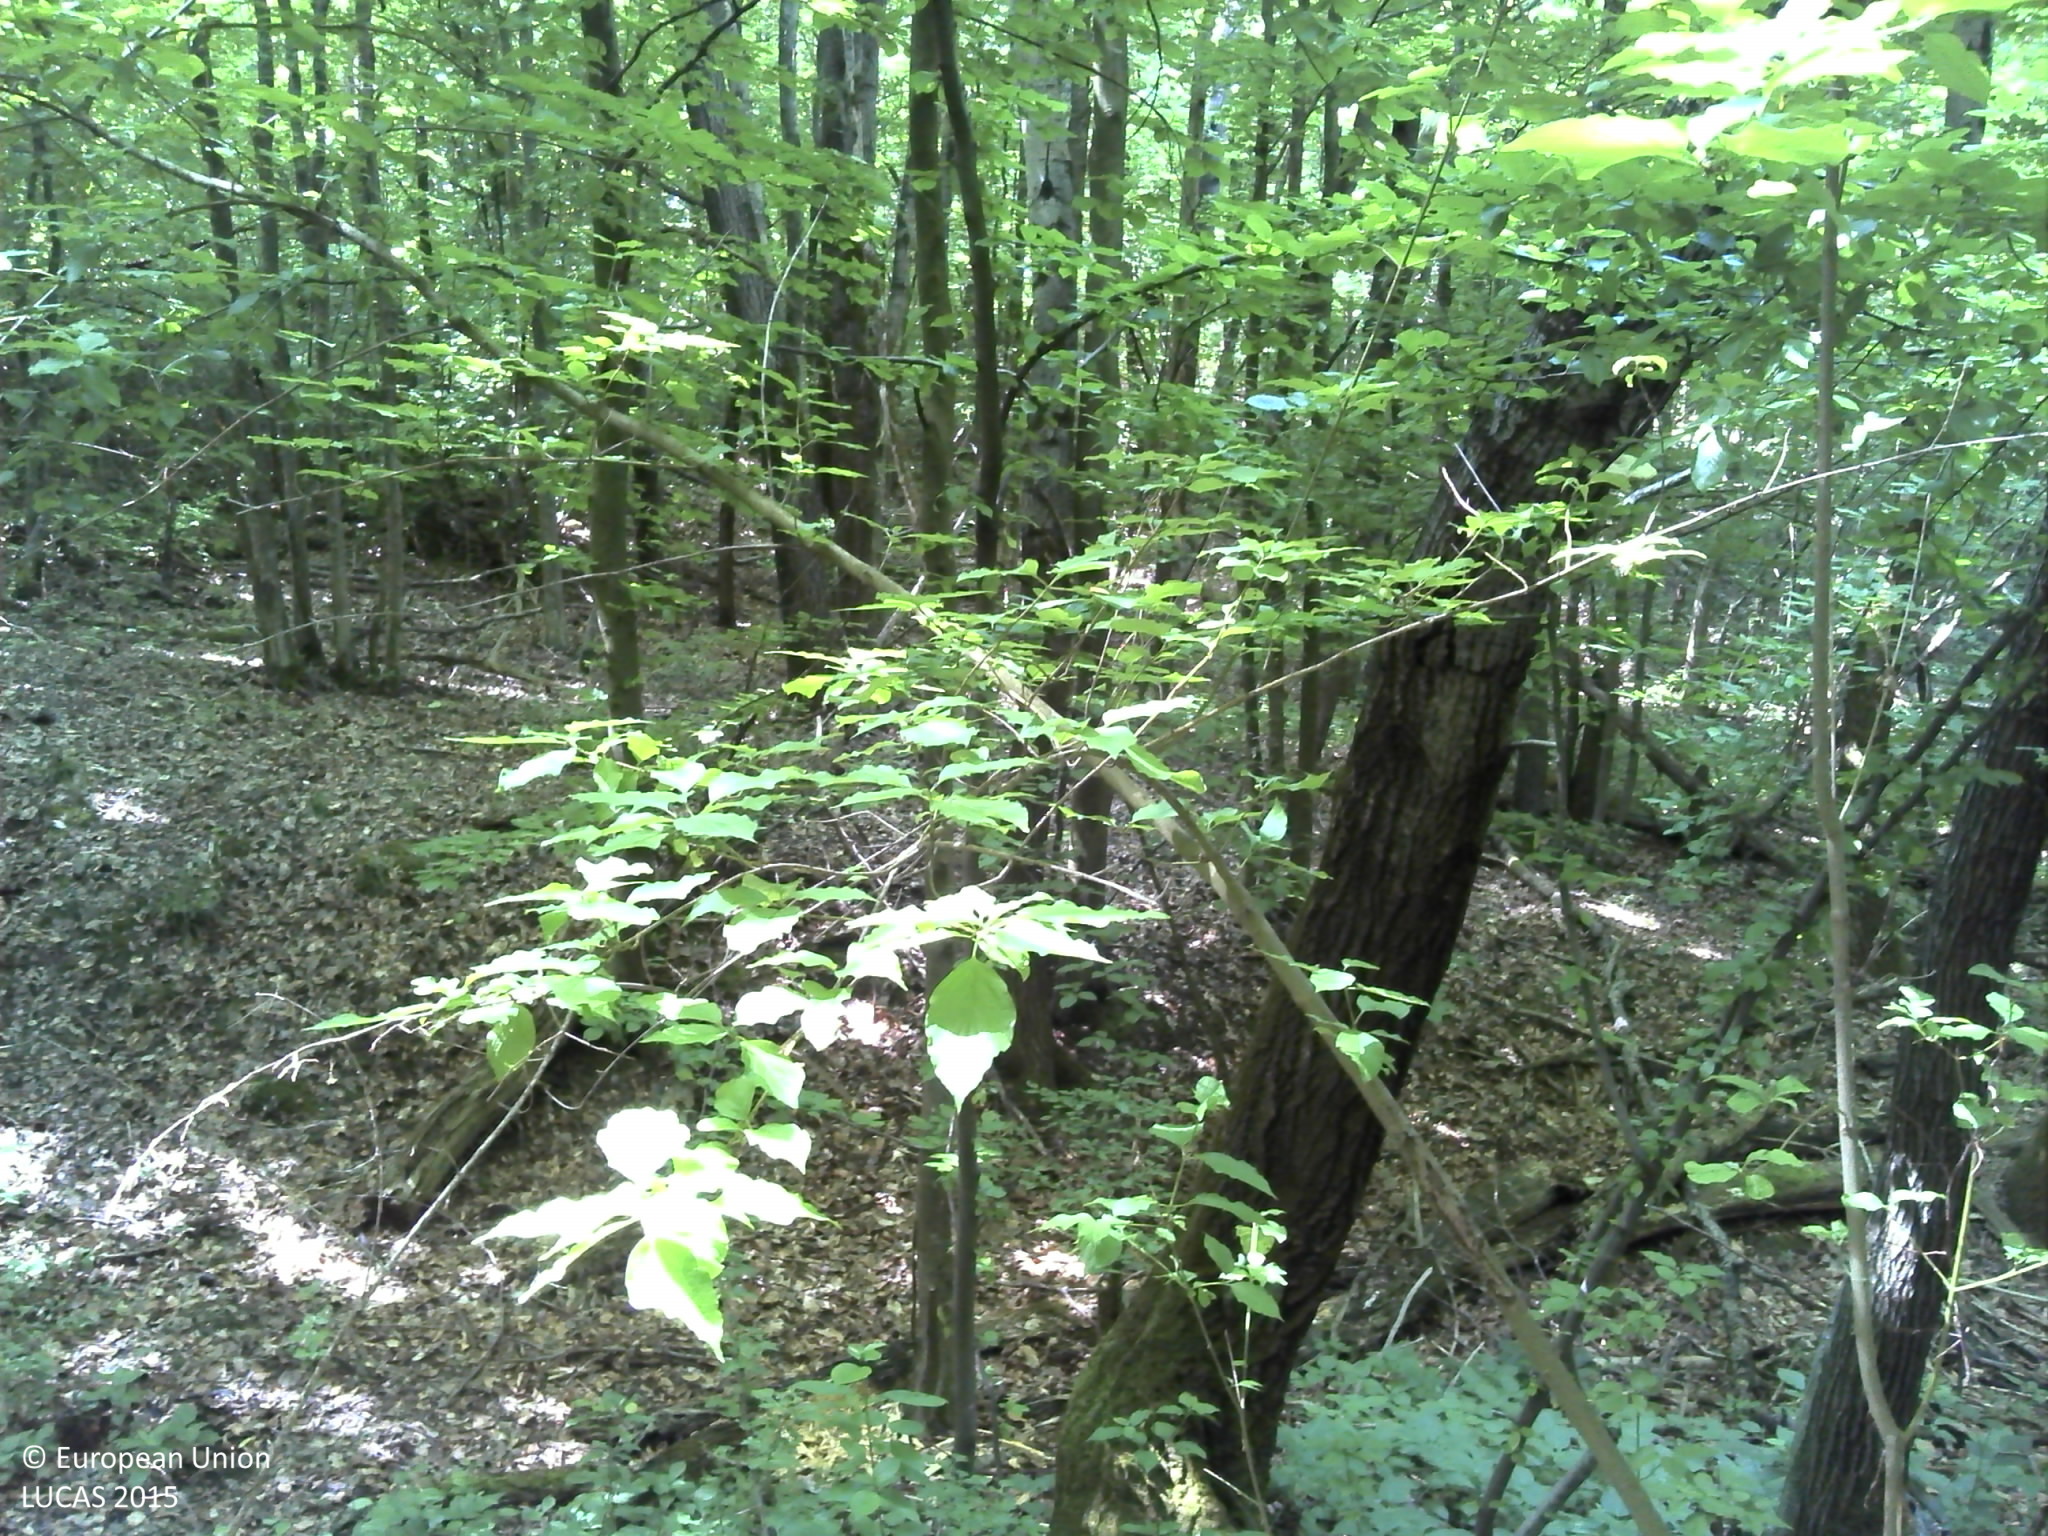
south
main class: Woodland
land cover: Broadleaved woodland
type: beech forest
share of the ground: > 75 %
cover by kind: broadleaved forest trees 100 %
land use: Forestry
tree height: > 5 m
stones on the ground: < 10 %
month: May
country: HR
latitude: 45.4504
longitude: 18.0464
